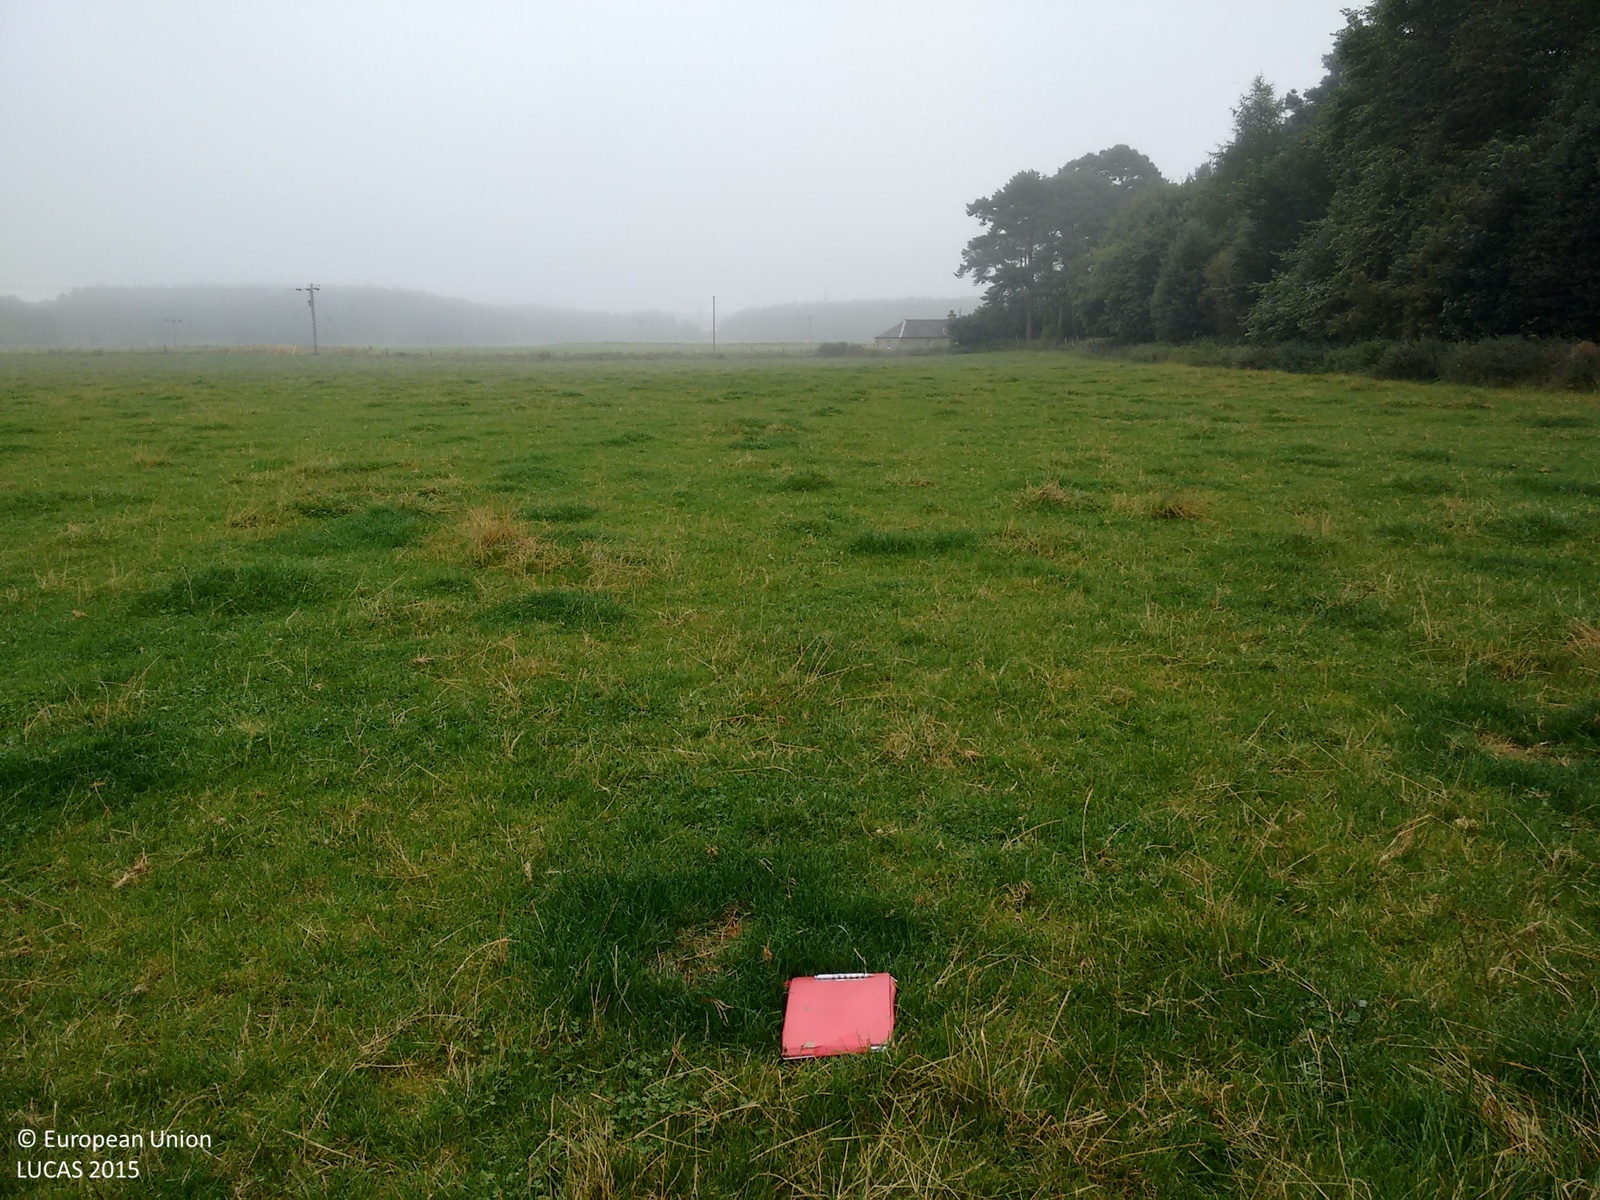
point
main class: Grassland
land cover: Grassland without tree/shrub cover
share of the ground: > 75 %
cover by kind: herbaceous plants 100 %
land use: Agriculture (excluding fallow land and kitchen gardens)
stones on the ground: < 10 %
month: September
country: GB
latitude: 57.5686
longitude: -3.8701
